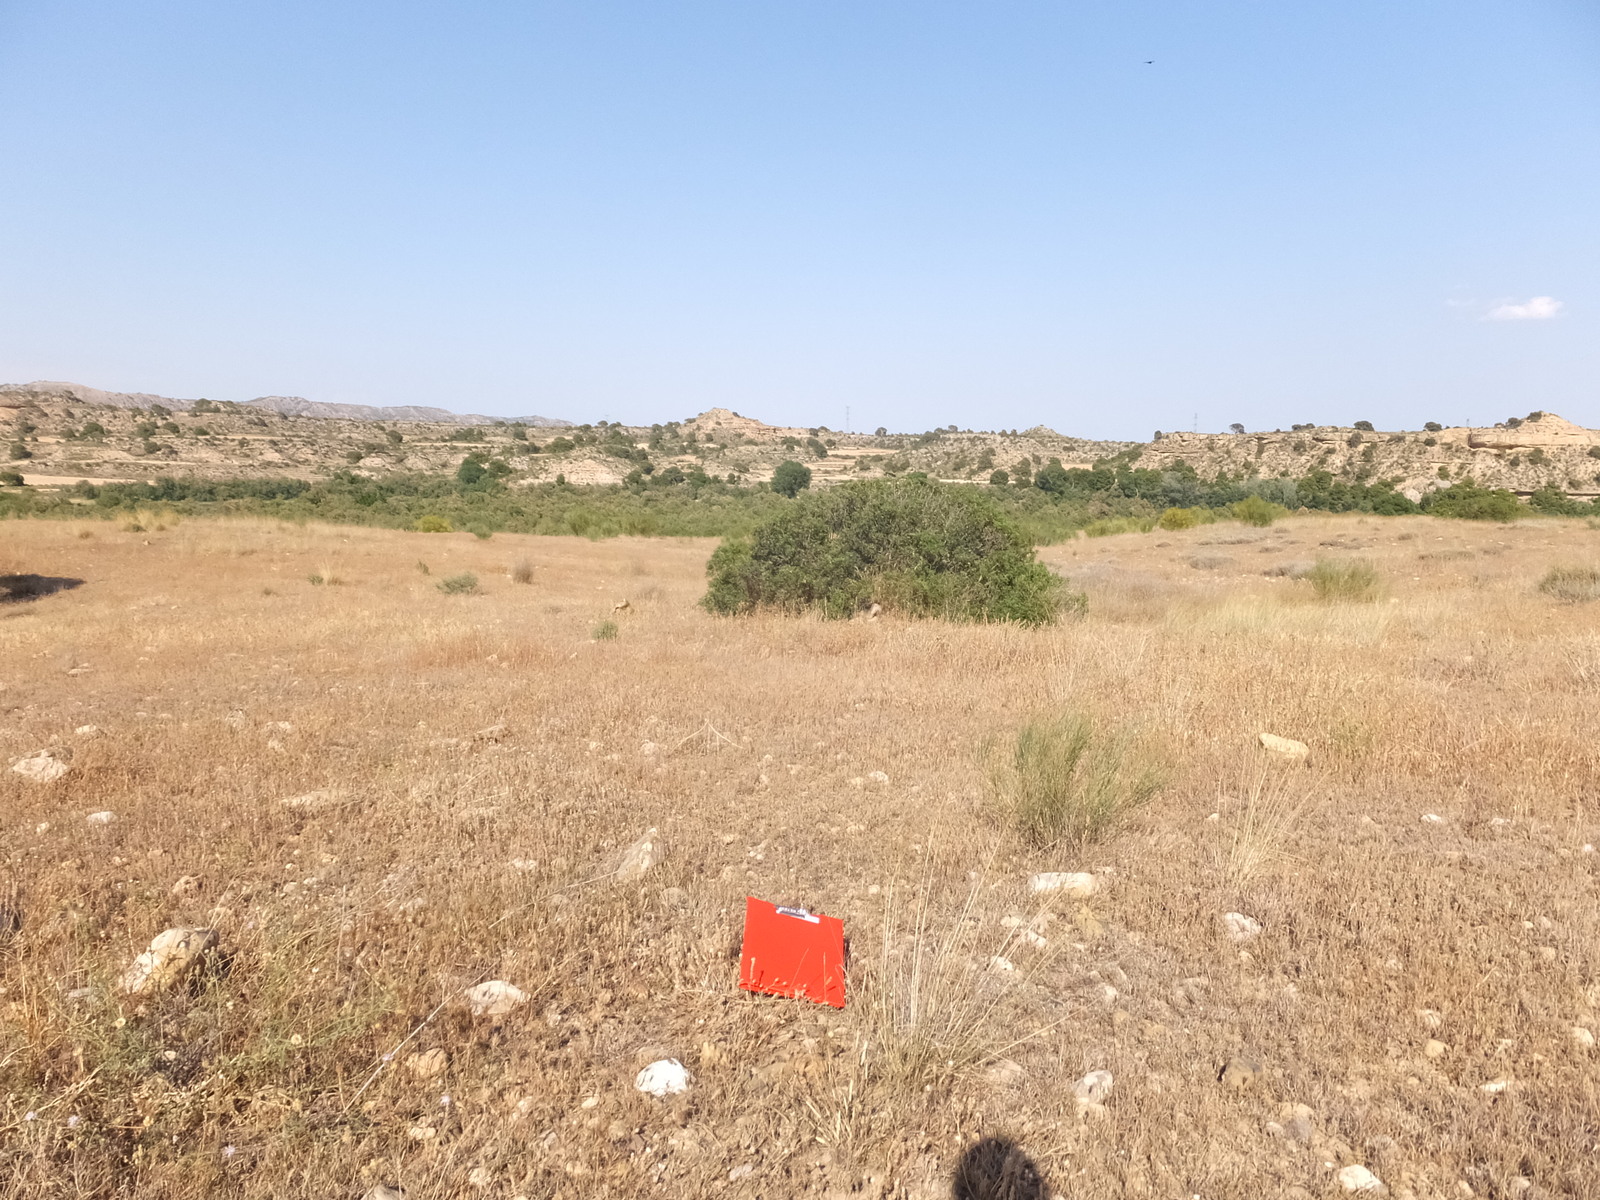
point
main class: Grassland
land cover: Grassland without tree/shrub cover
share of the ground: 50 - 75 %
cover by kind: herbaceous plants 70 %, consolidated bare surface 25 %, shrubs 5 %
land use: Abandoned areas
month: June
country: ES
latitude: 41.2982
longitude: -0.2249
